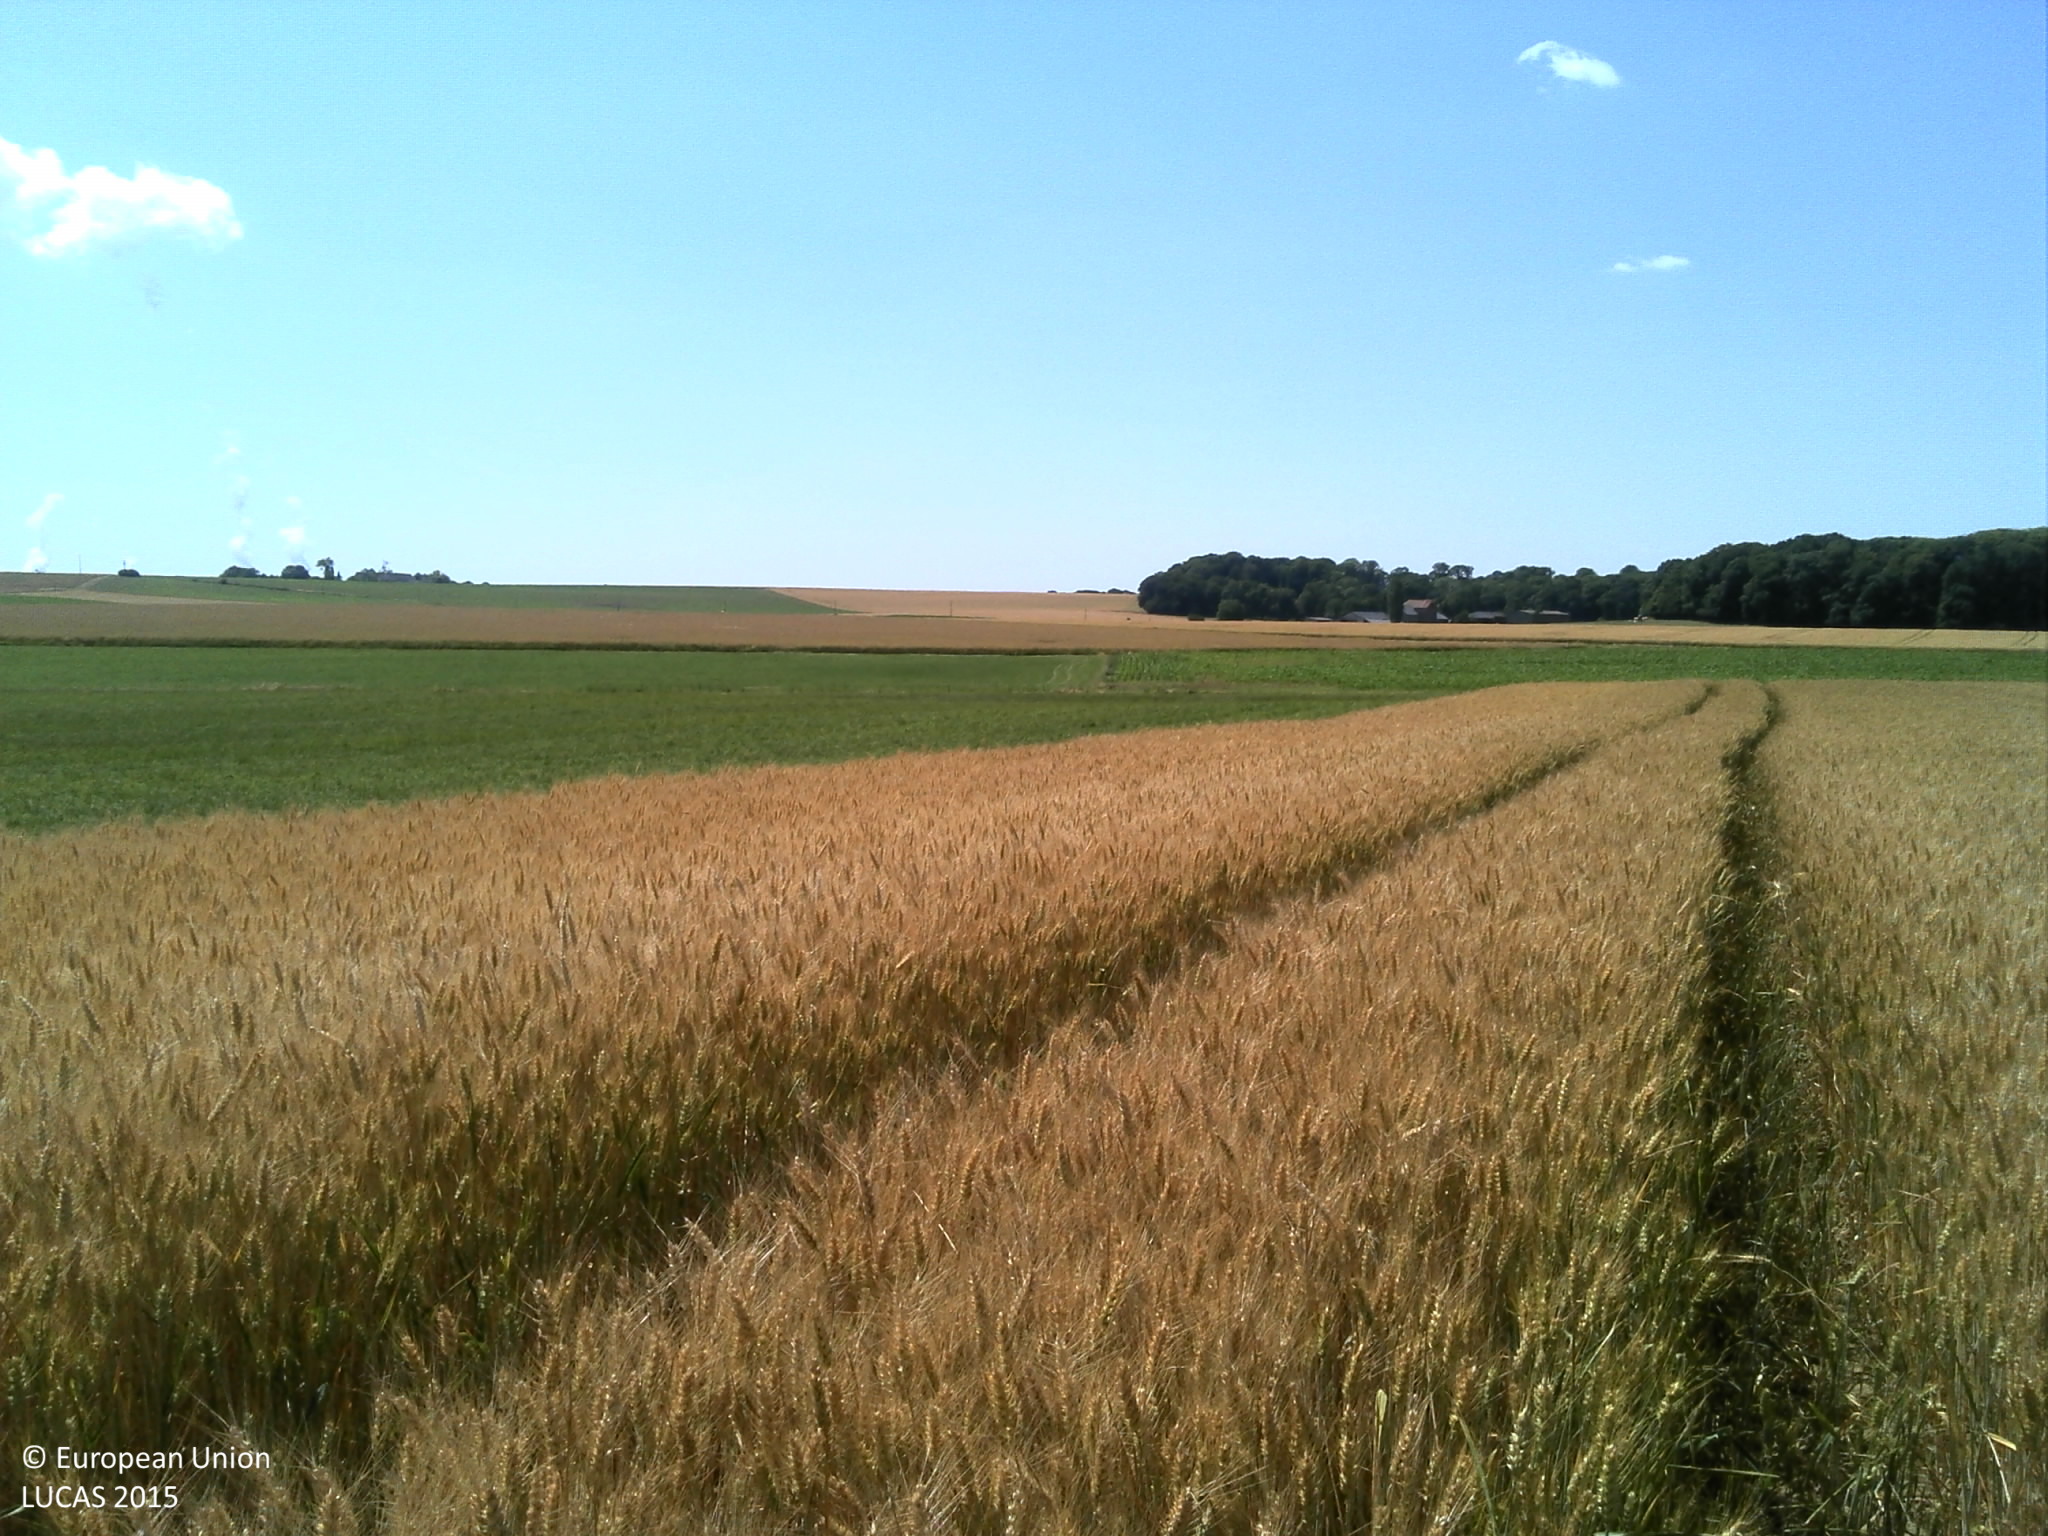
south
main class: Cropland
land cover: Common wheat
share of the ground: > 75 %
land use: Agriculture (excluding fallow land and kitchen gardens)
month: July
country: FR
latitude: 49.4900
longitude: 6.1755
